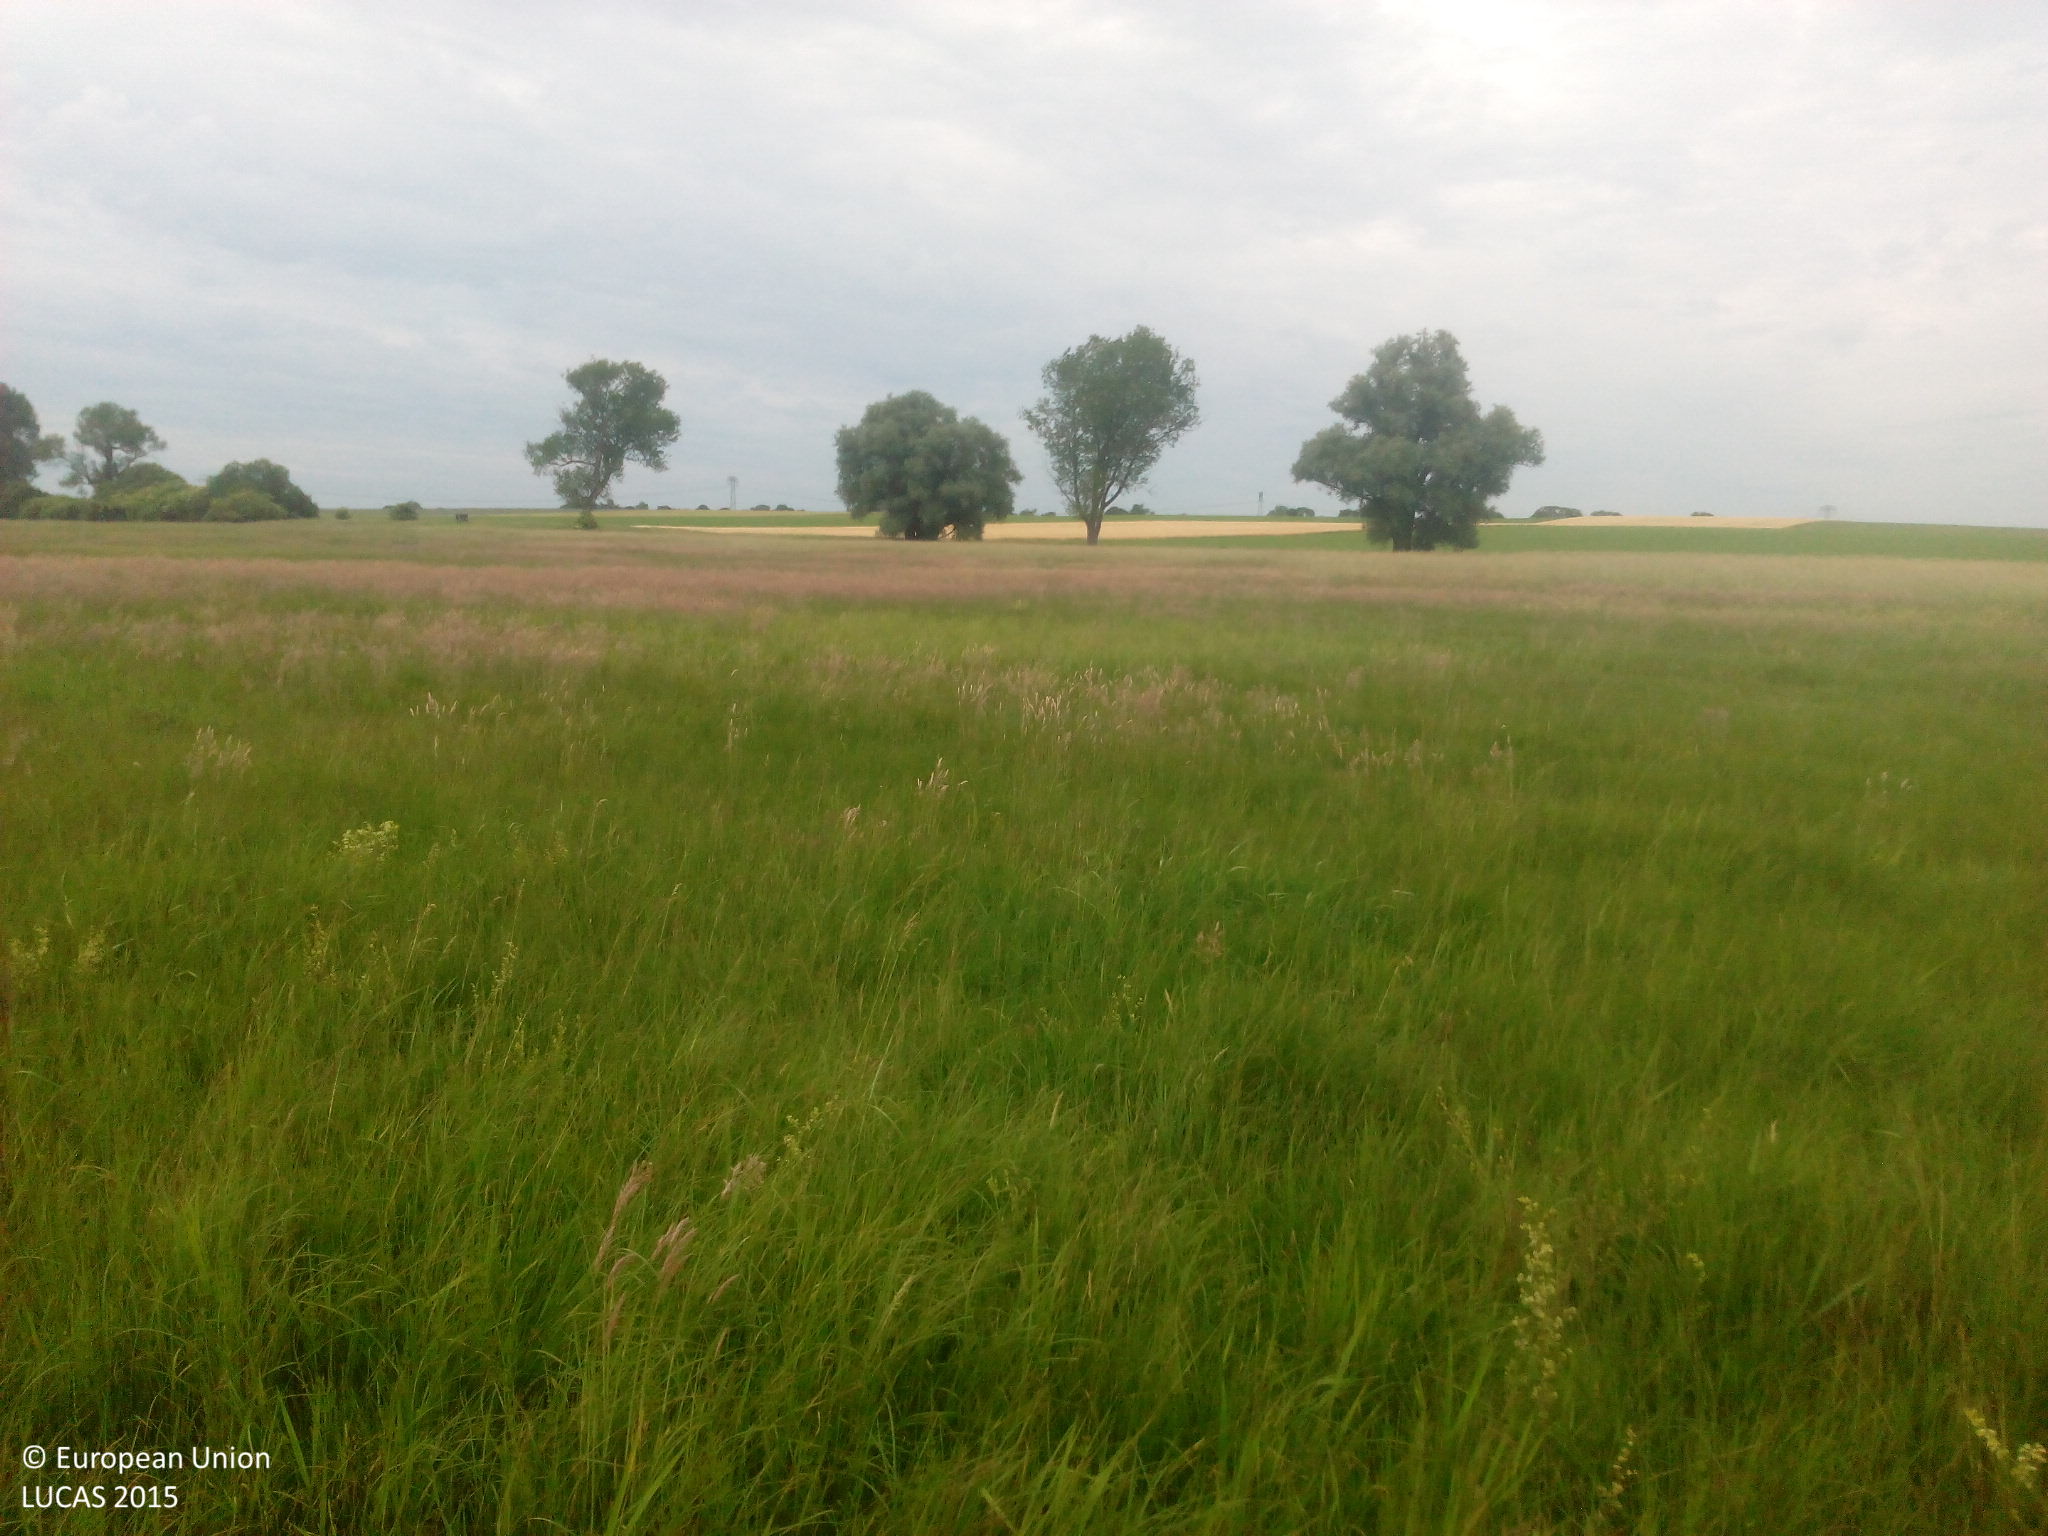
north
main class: Grassland
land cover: Grassland without tree/shrub cover
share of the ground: > 75 %
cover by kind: herbaceous plants 100 %
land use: Semi-natural and natural areas not in use
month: June
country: DE
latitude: 52.6191
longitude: 12.5845
